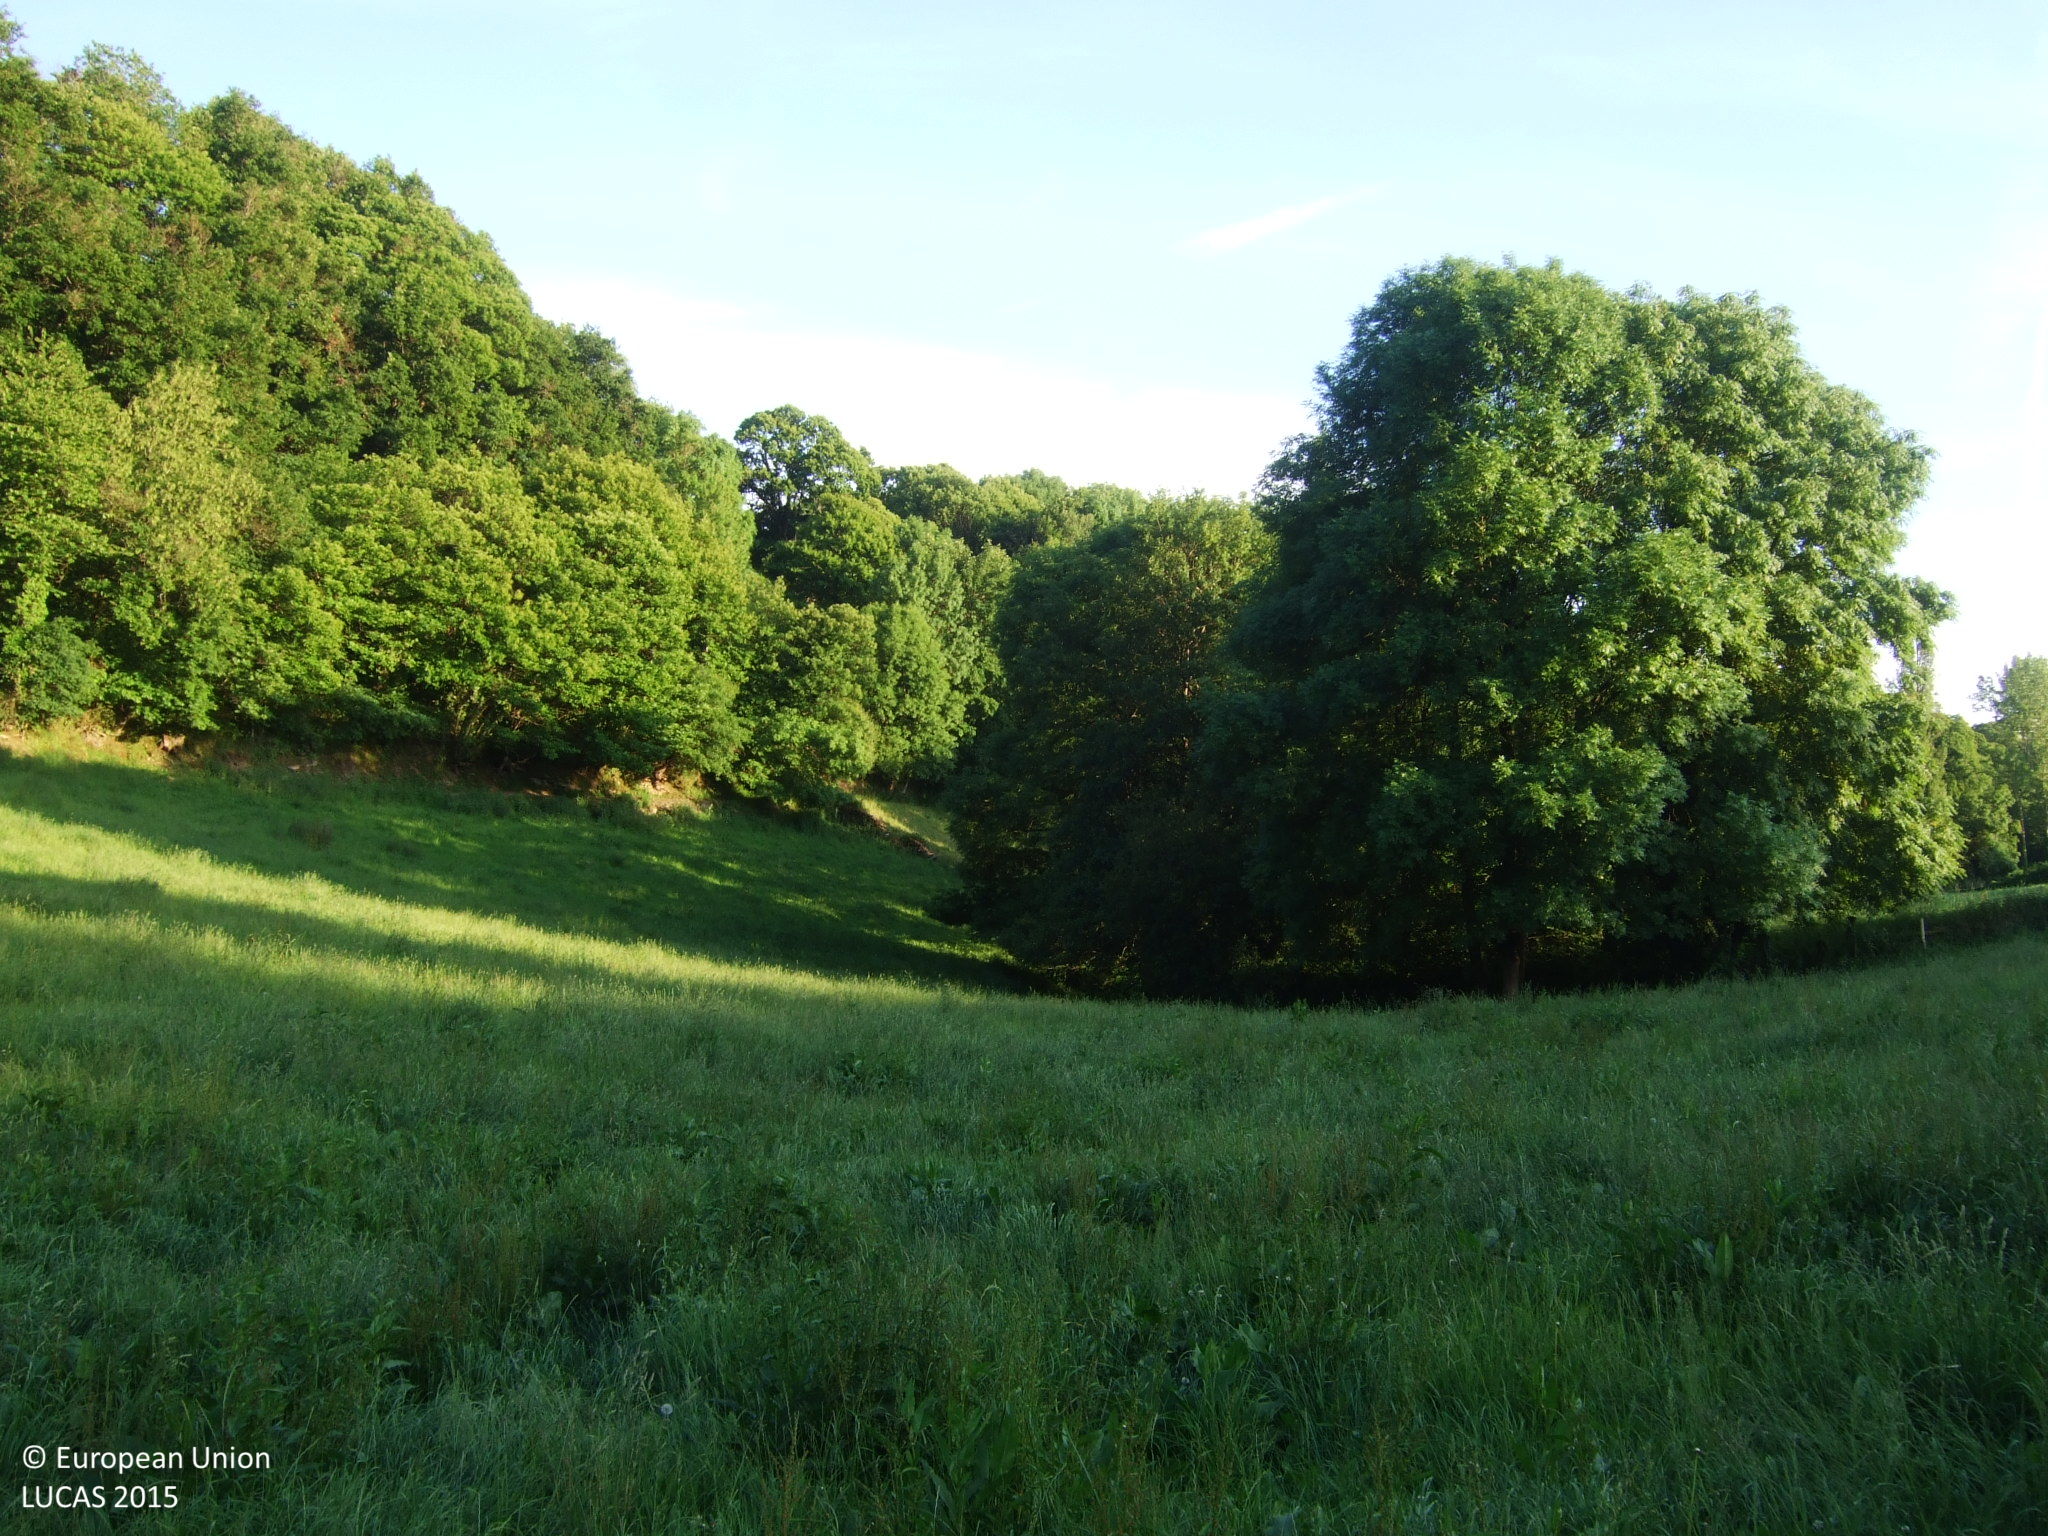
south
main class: Grassland
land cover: Grassland without tree/shrub cover
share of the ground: > 75 %
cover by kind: herbaceous plants 100 %
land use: Agriculture (excluding fallow land and kitchen gardens)
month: June
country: ES
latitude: 42.7713
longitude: -7.3121
